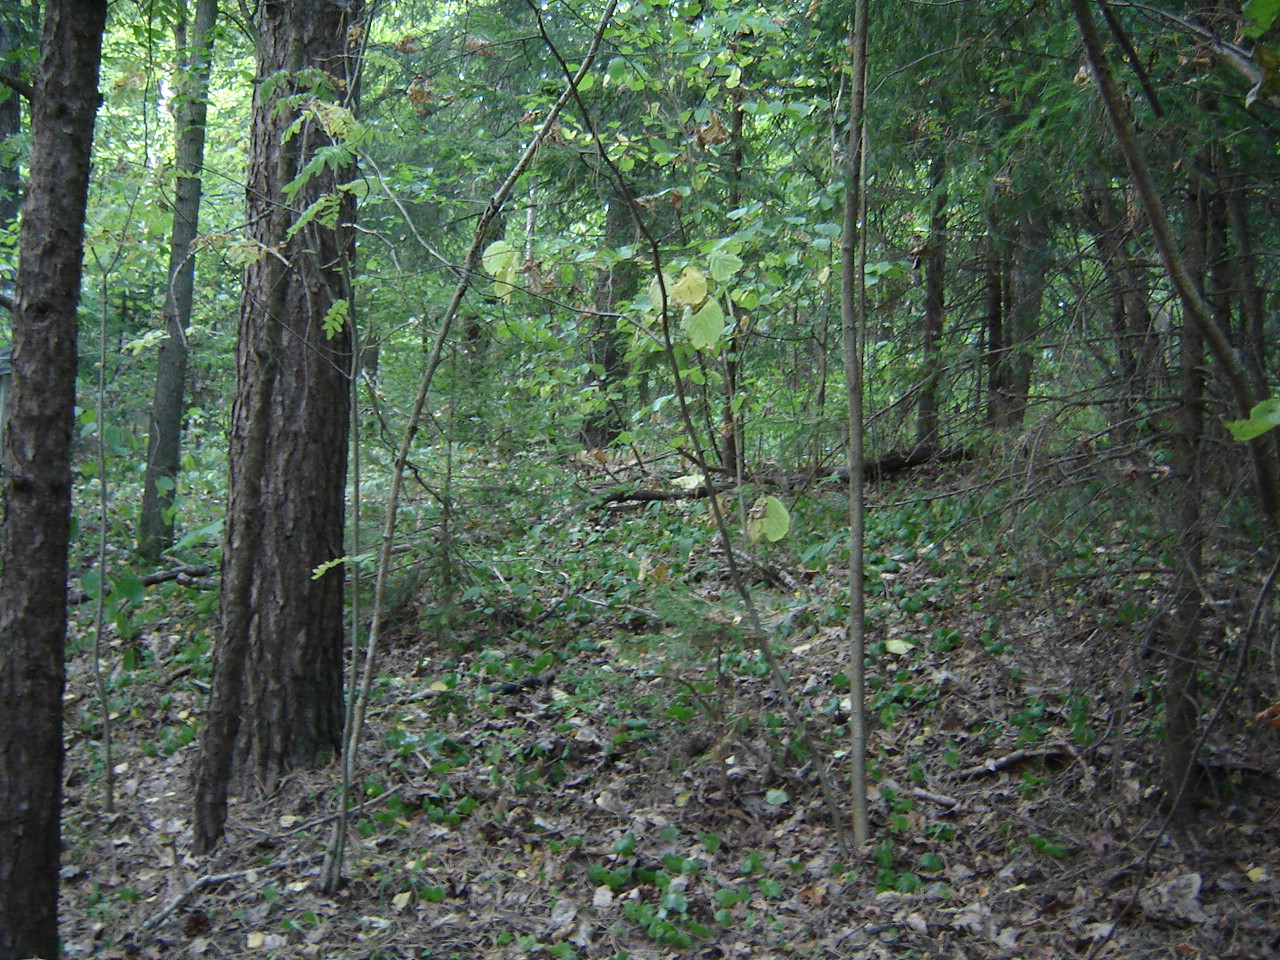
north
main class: Woodland
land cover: Pine dominated mixed woodland
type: hemiboreal forest and nemoral coniferous forest and mixed broadleaved-coniferous forest
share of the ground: > 75 %
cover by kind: coniferous forest trees 65 %, broadleaved forest trees 30 %, unconsolidated bare surface 5 %
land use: Forestry
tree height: > 5 m
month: August
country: LT
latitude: 54.8047
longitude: 24.8432
